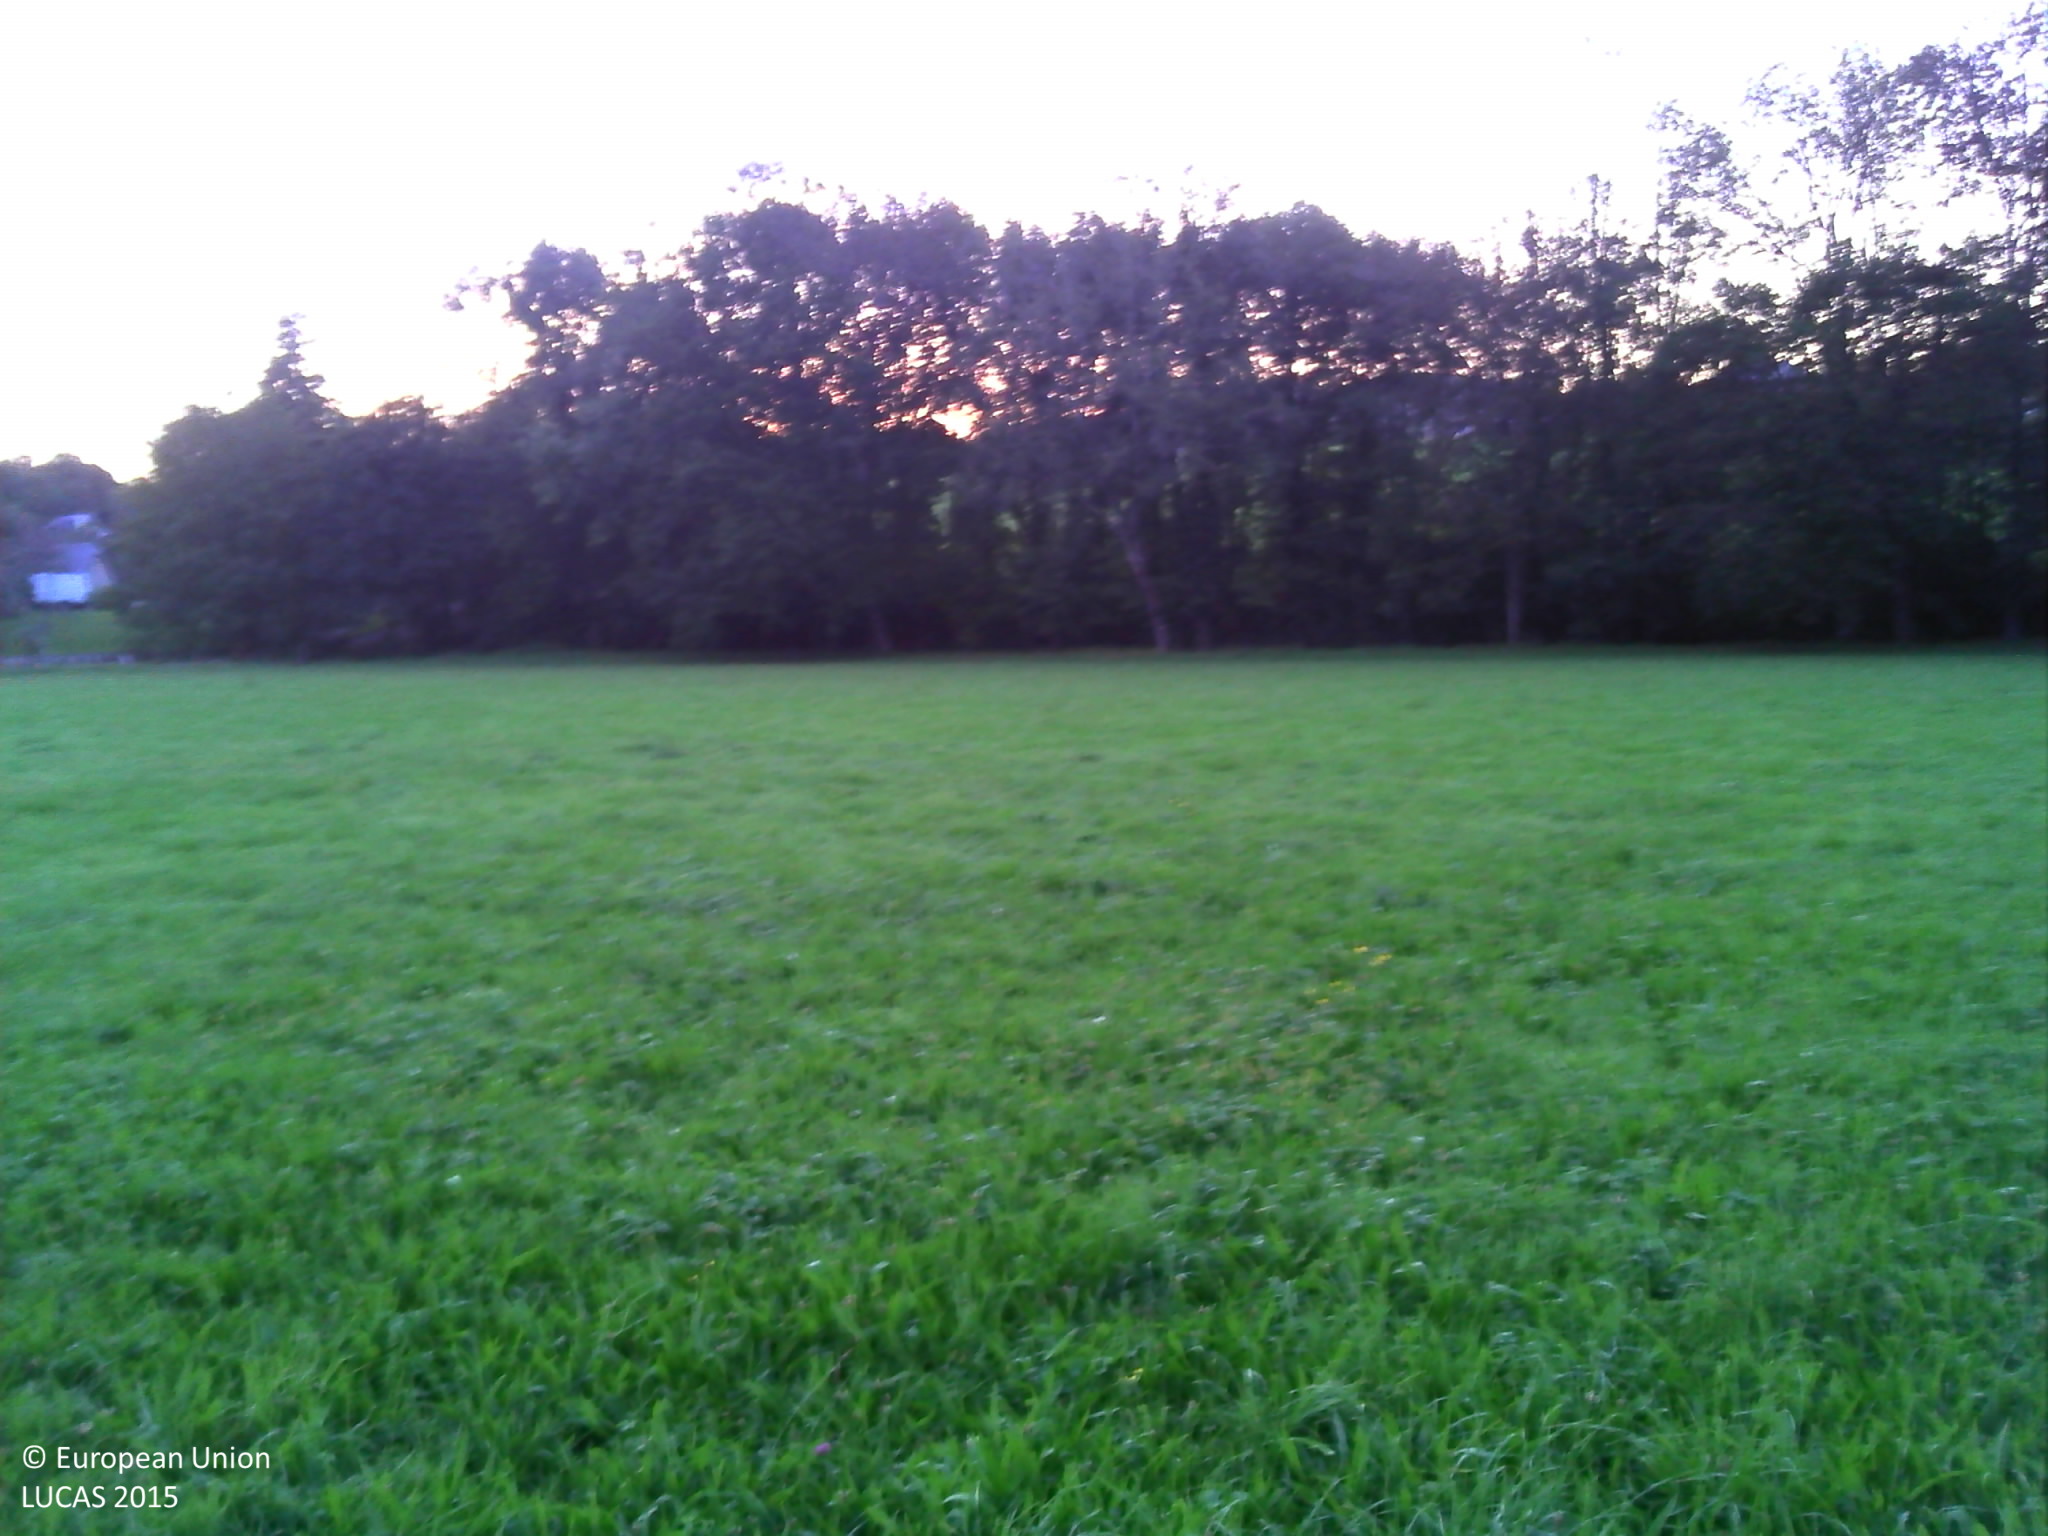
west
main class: Grassland
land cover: Grassland without tree/shrub cover
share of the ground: > 75 %
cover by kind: herbaceous plants 100 %
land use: Agriculture (excluding fallow land and kitchen gardens)
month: September
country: FR
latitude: 43.1418
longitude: -0.6927
